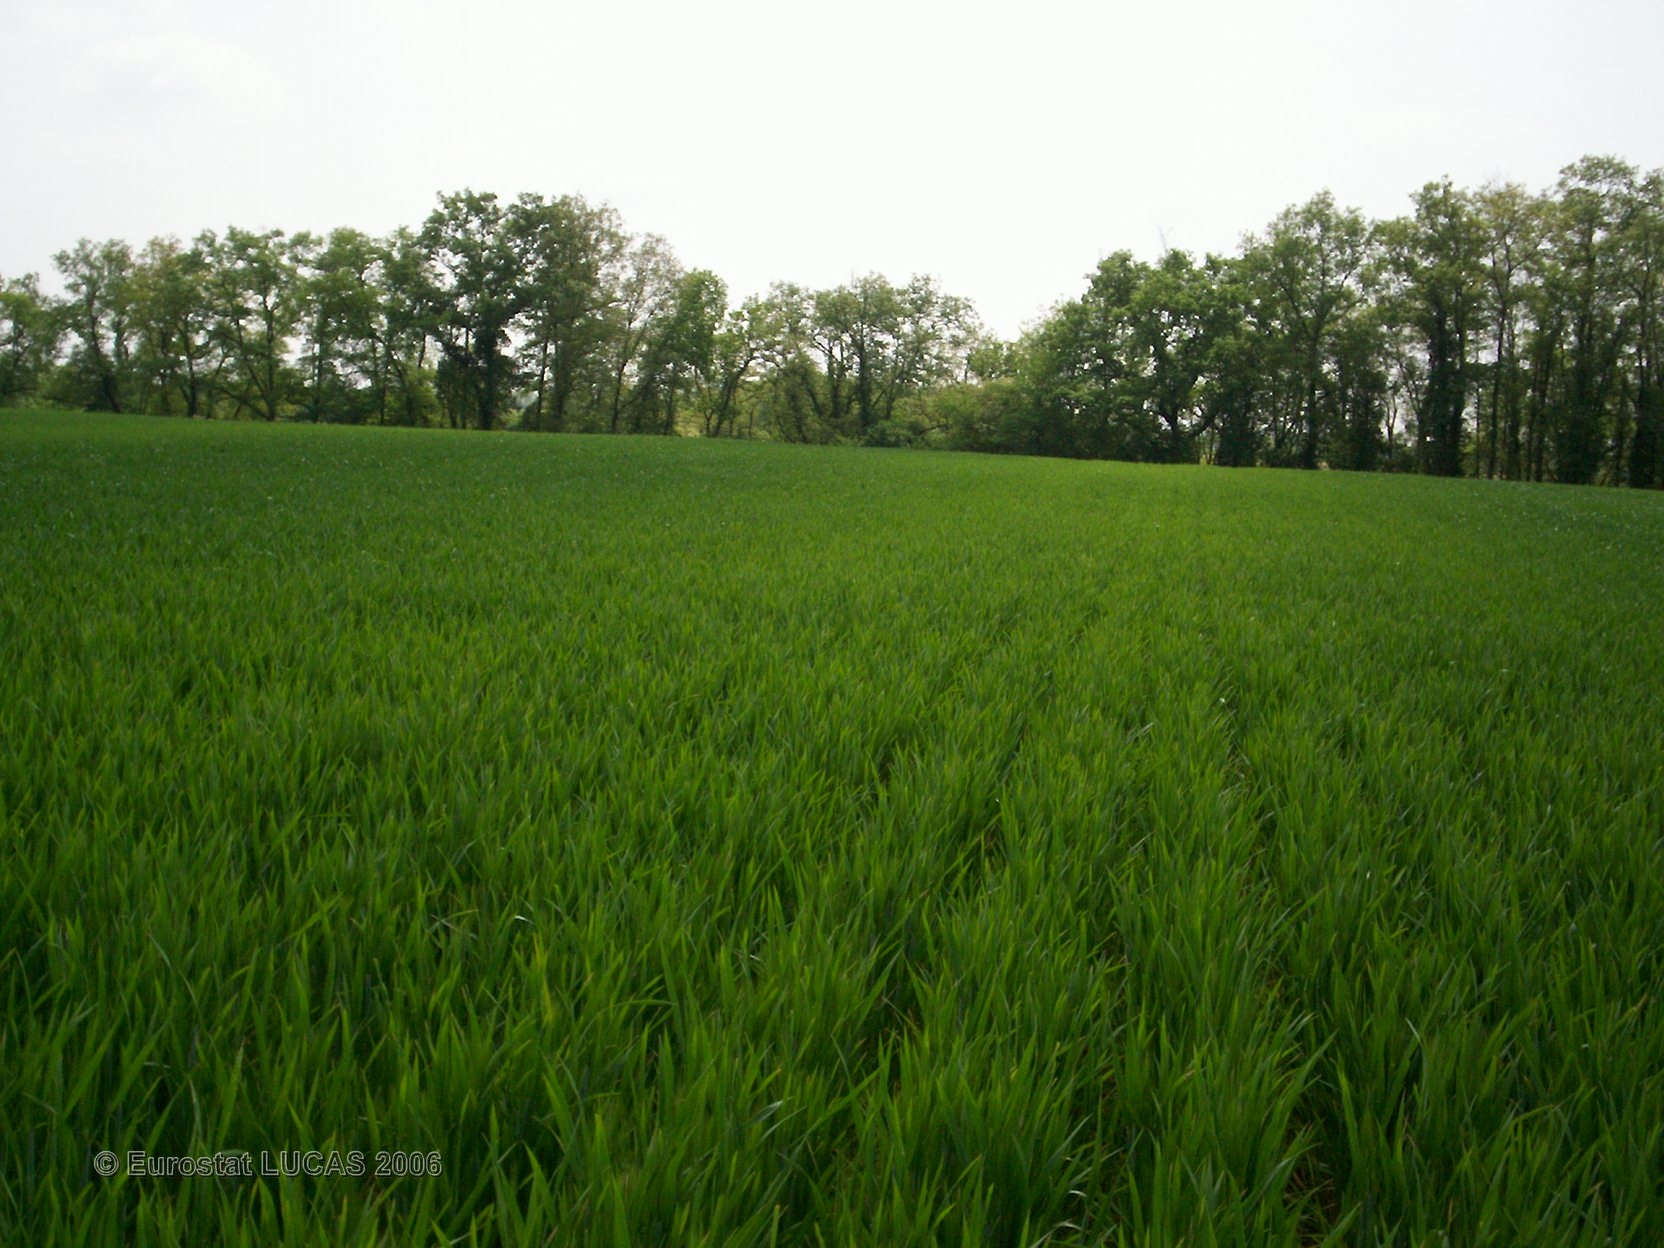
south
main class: Cropland
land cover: Barley
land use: Agriculture (excluding fallow land and kitchen gardens)
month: May
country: FR
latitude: 43.9795
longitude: 0.2320
